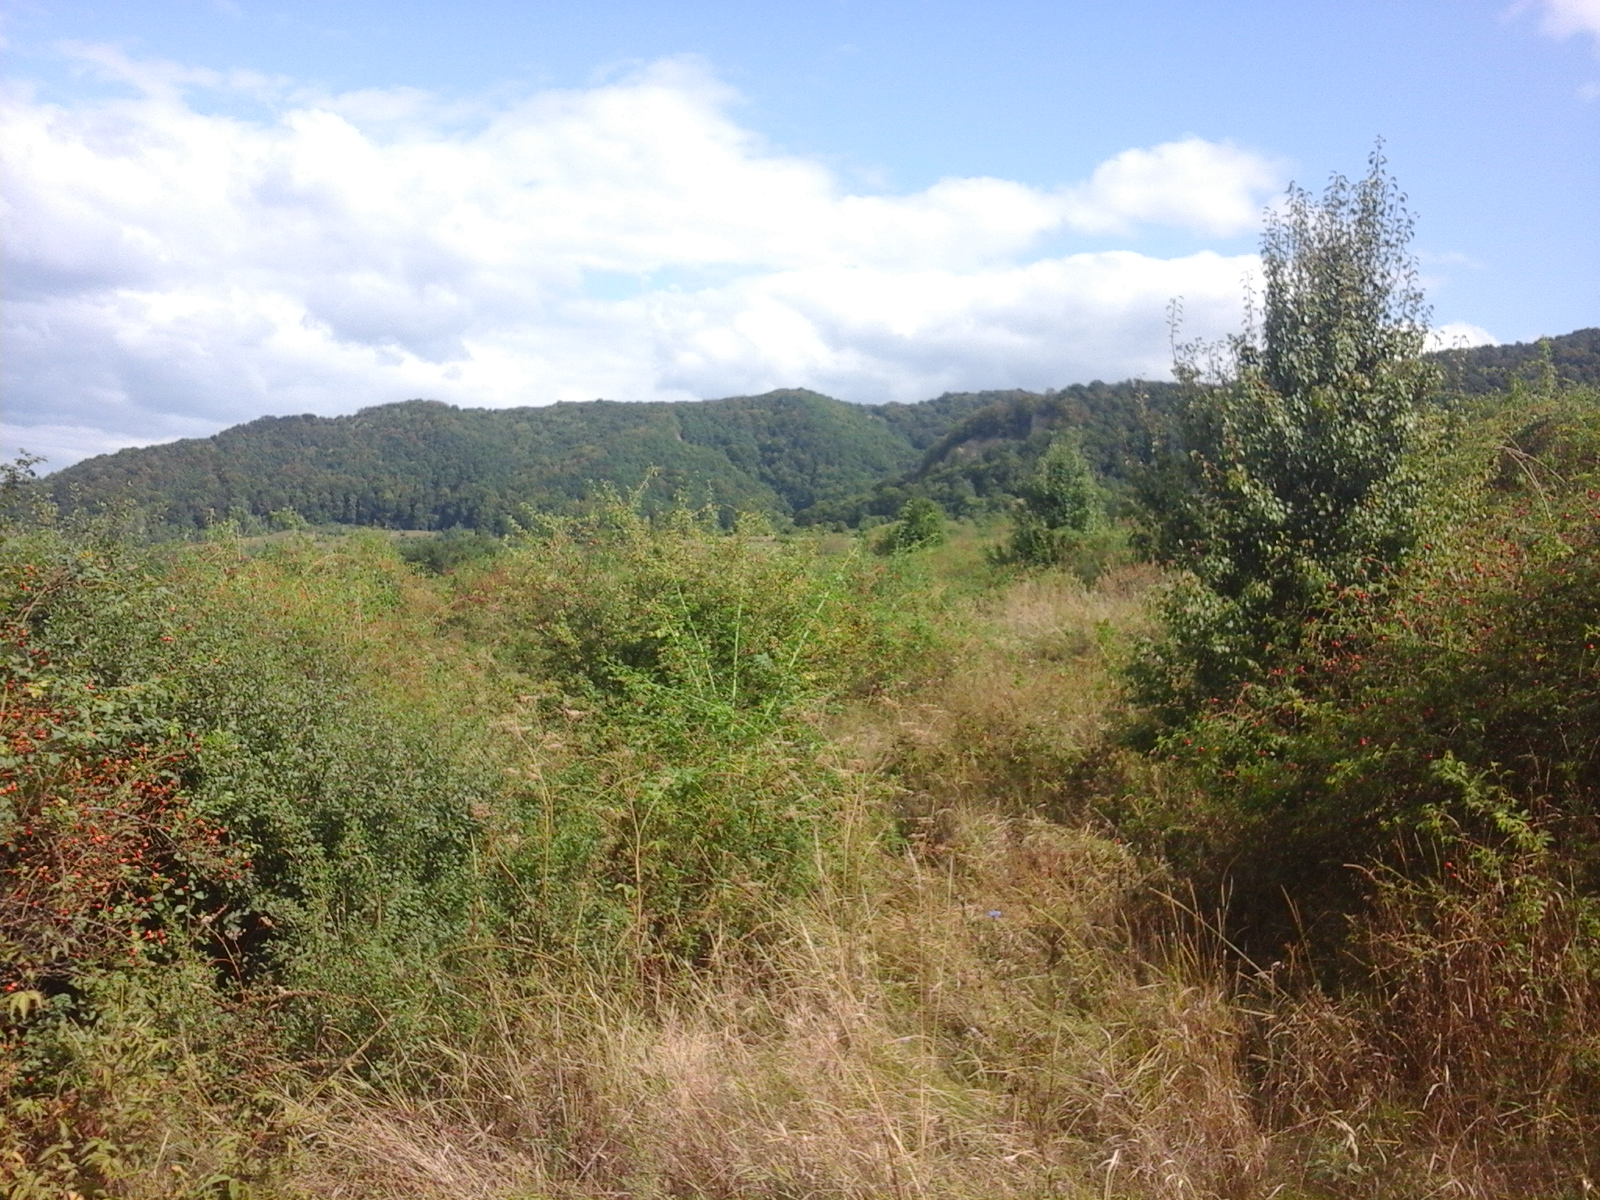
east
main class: Grassland
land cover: Grassland with sparse tree/shrub cover
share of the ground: > 75 %
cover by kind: herbaceous plants 85 %, shrubs 10 %, broadleaved forest trees 5 %
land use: Fallow land
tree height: < 5 m
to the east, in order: Grassland with sparse tree/shrub cover; Spontaneously vegetated surfaces; Grassland with sparse tree/shrub cover
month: September
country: RO
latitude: 47.3983
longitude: 23.7110
